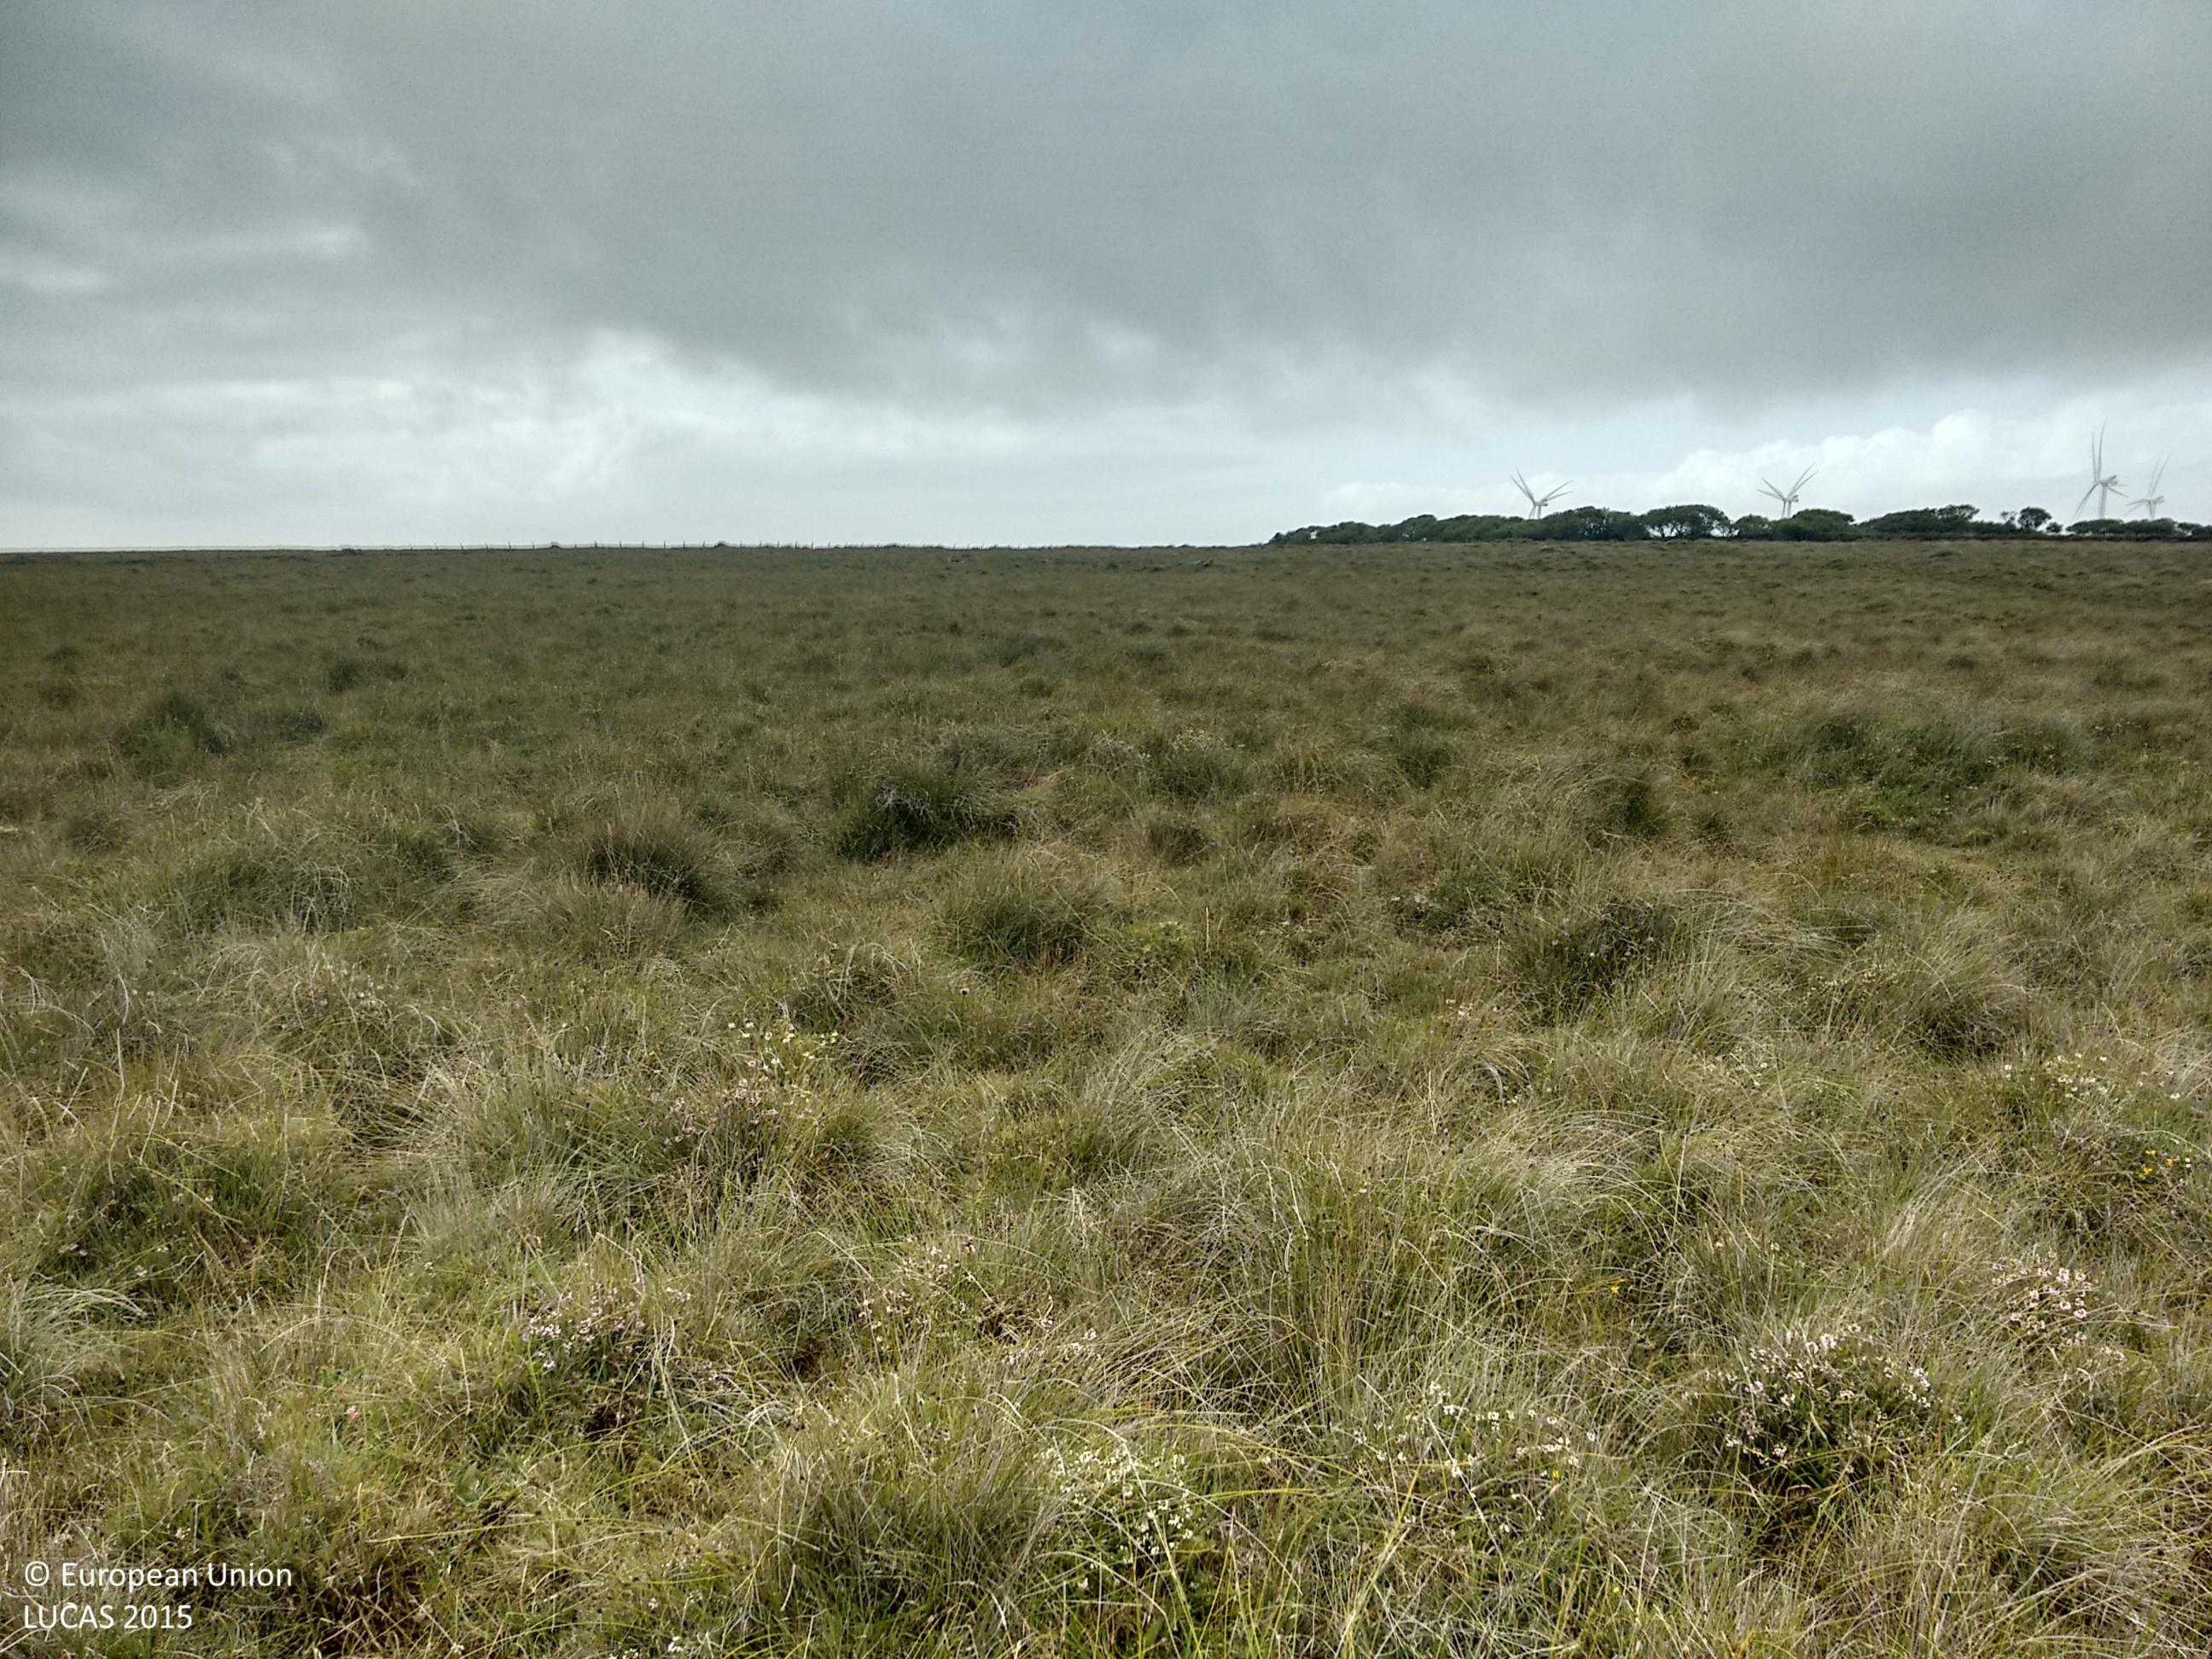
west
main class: Grassland
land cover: Grassland without tree/shrub cover
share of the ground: > 75 %
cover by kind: herbaceous plants 100 %
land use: Agriculture (excluding fallow land and kitchen gardens)
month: August
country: GB
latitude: 50.0378
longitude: -5.1846
